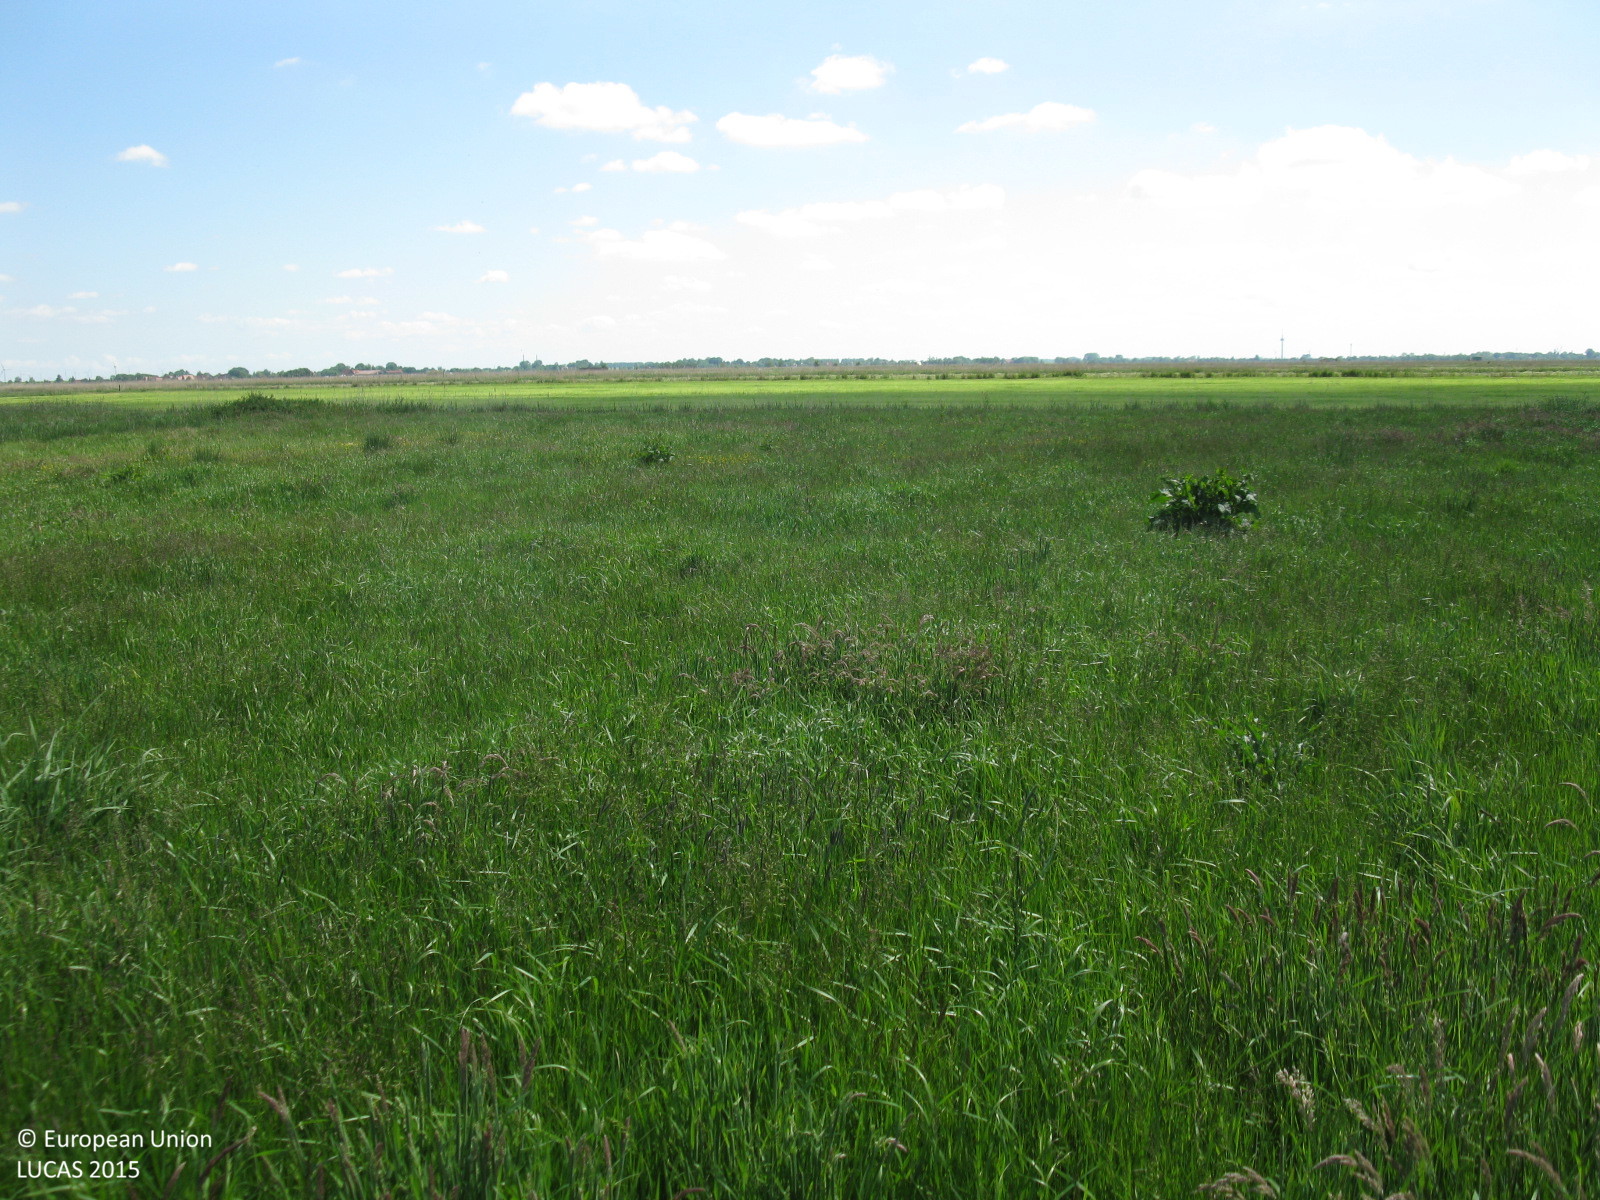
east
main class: Grassland
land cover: Grassland without tree/shrub cover
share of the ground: > 75 %
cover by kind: herbaceous plants 100 %
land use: Agriculture (excluding fallow land and kitchen gardens)
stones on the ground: < 10 %
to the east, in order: Grassland without tree/shrub cover; Ditches and canals; Grassland without tree/shrub cover; Ditches and canals; Grassland without tree/shrub cover; Ditches and canals; Grassland without tree/shrub cover; Ditches and canals; Grassland without tree/shrub cover
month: June
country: DE
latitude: 53.2823
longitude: 7.3158
